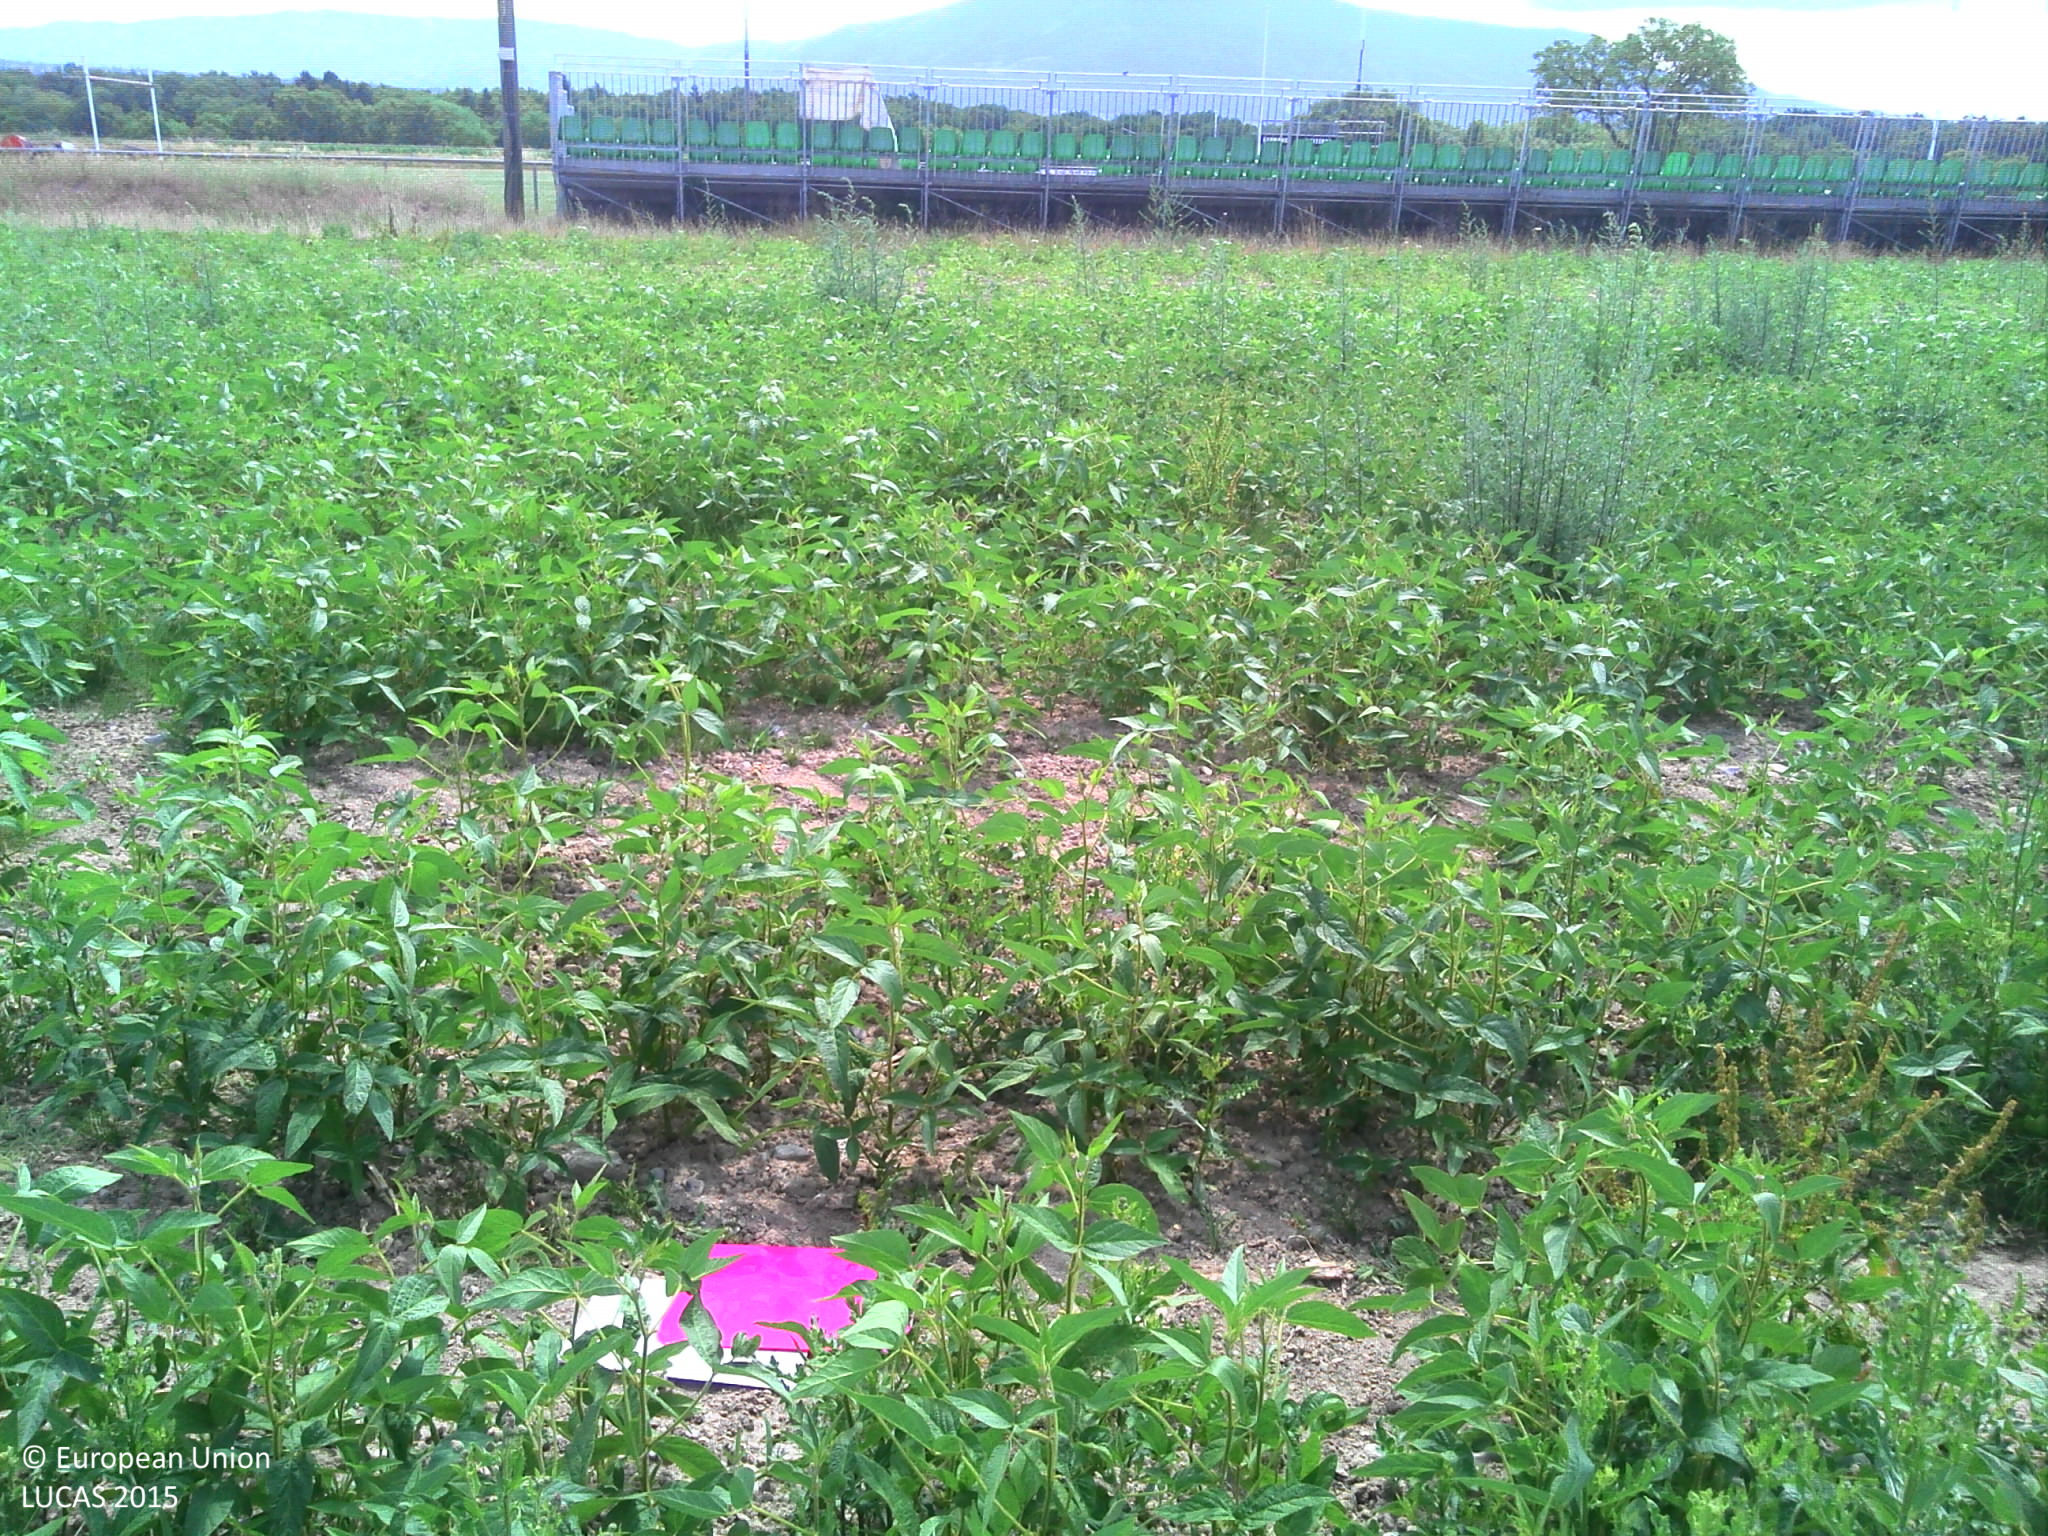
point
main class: Cropland
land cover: Soya
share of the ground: > 75 %
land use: Agriculture (excluding fallow land and kitchen gardens)
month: July
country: FR
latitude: 46.3036
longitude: 6.2510
